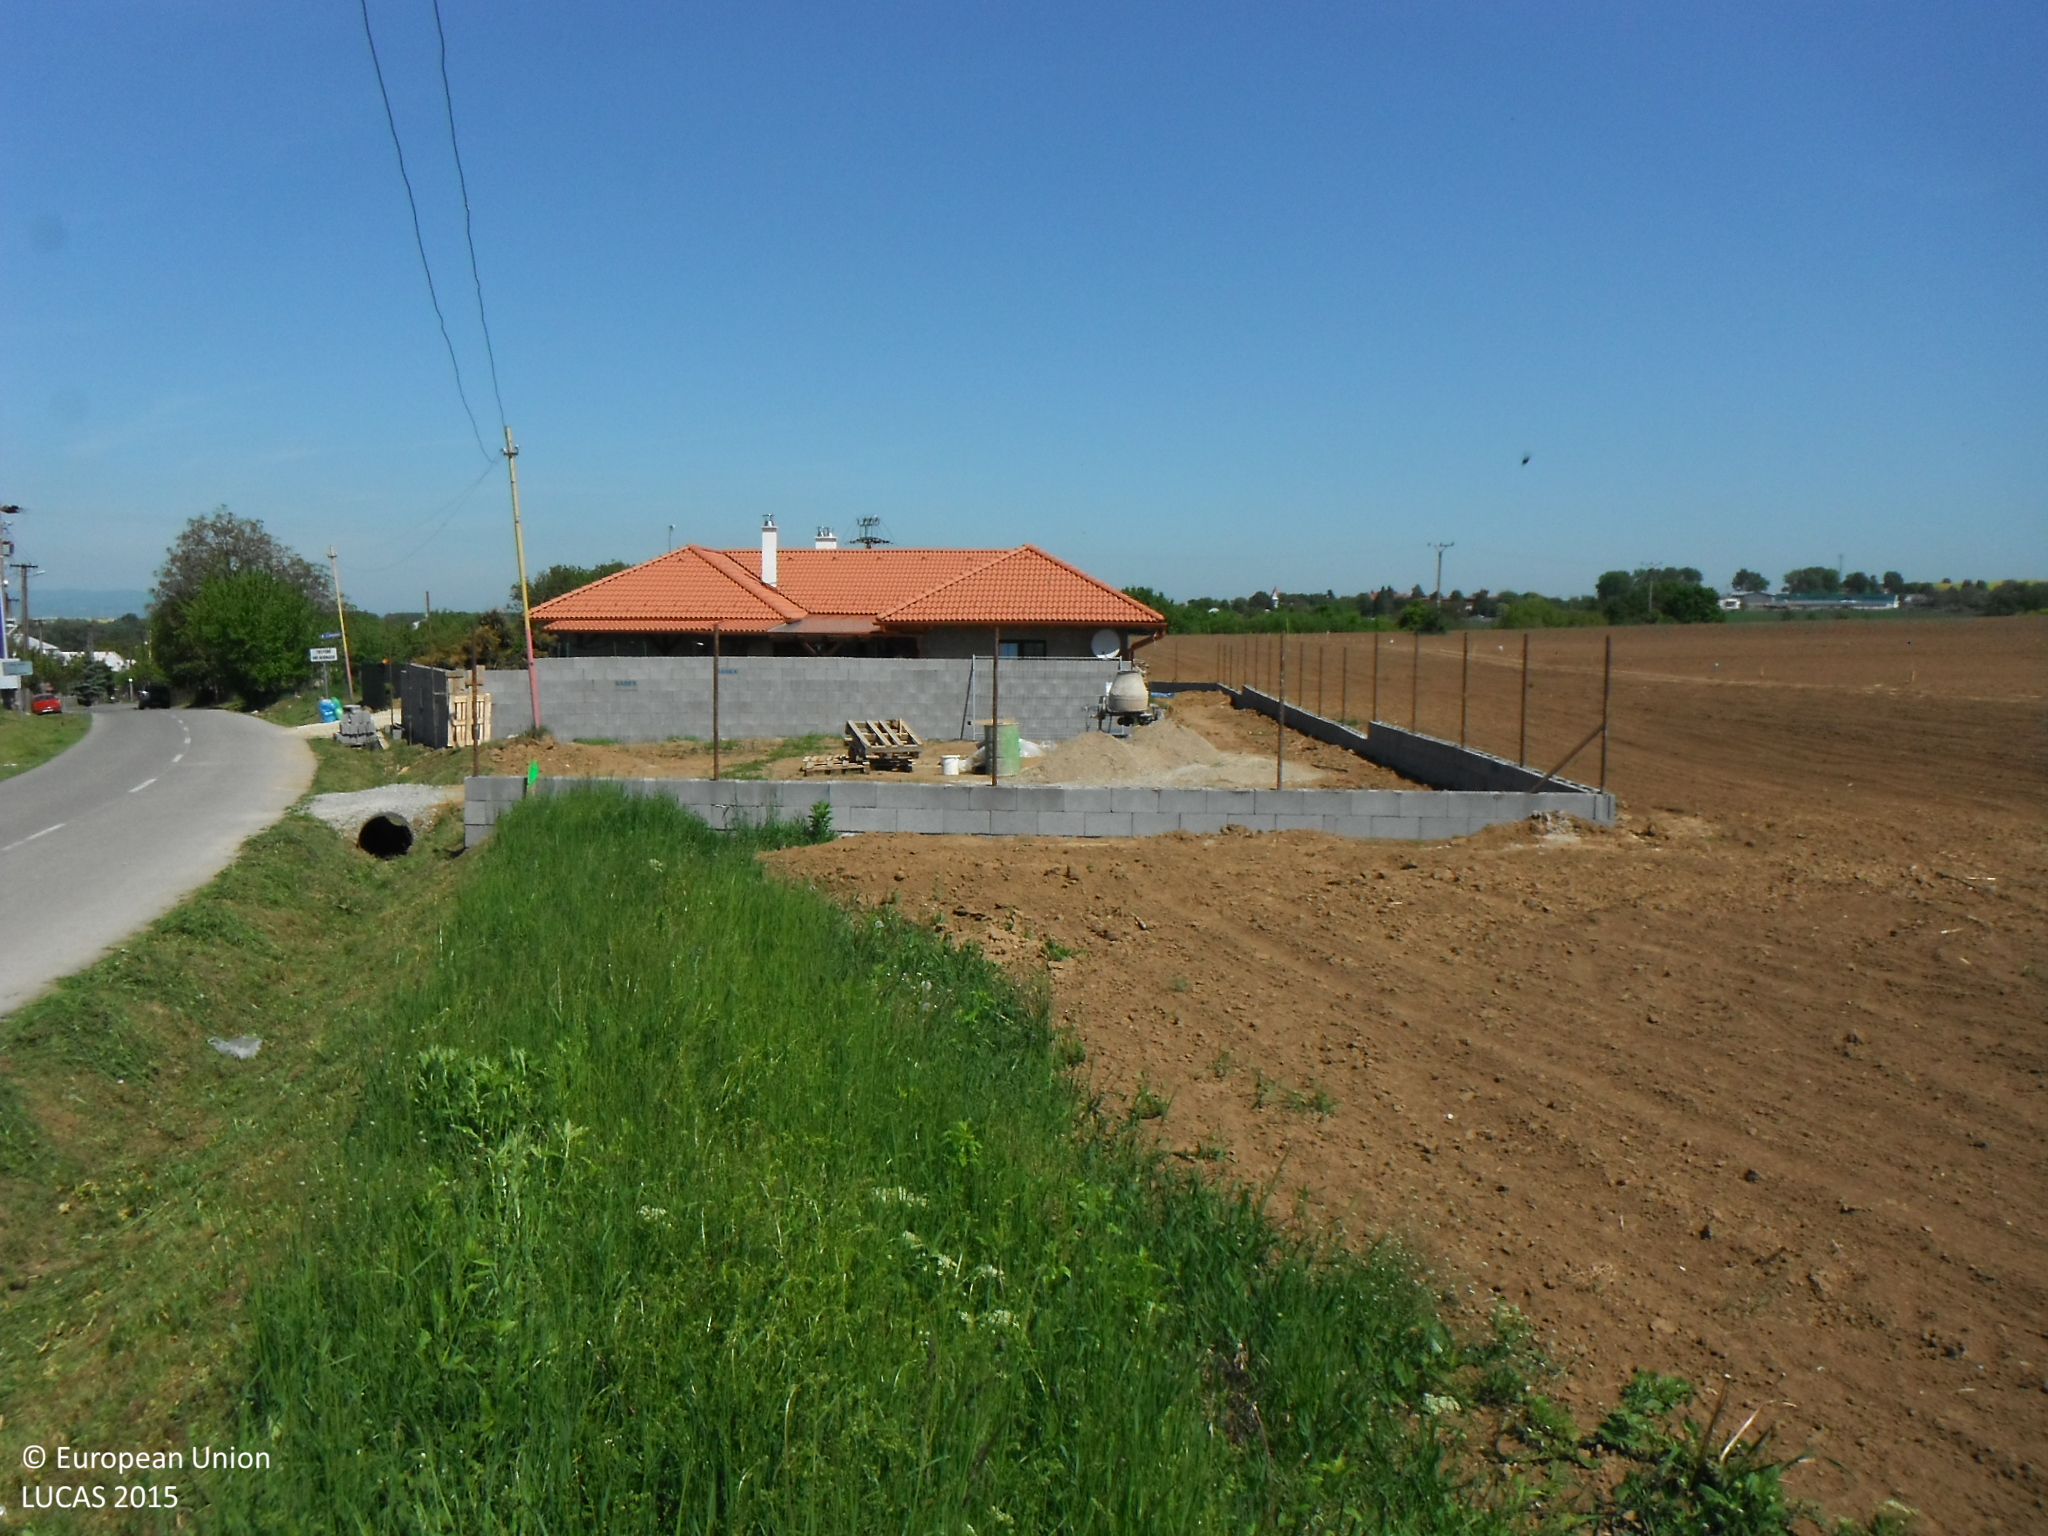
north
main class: Cropland
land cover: Maize
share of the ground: < 10 %
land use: Agriculture (excluding fallow land and kitchen gardens)
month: May
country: SK
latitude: 48.5636
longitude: 21.3328
